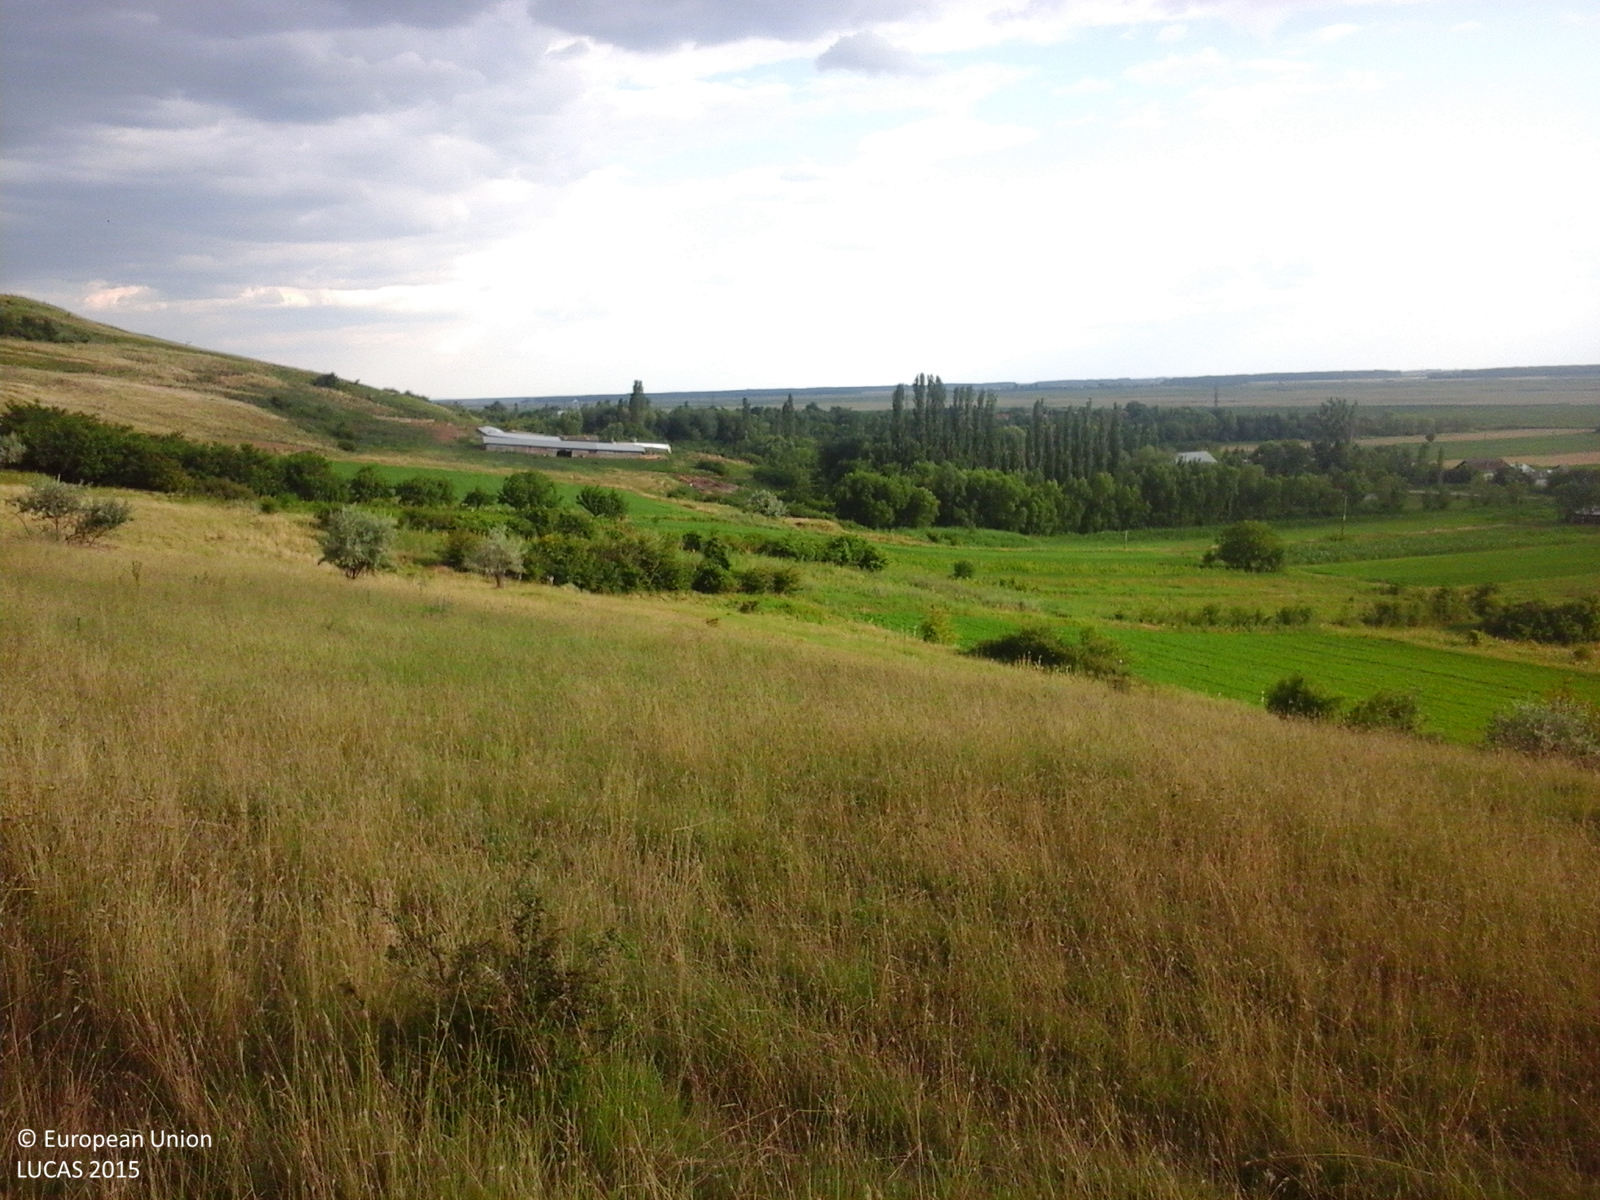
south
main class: Grassland
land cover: Grassland with sparse tree/shrub cover
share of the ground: > 75 %
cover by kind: herbaceous plants 85 %, shrubs 10 %, broadleaved forest trees 5 %
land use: Agriculture (excluding fallow land and kitchen gardens)
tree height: < 5 m
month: July
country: RO
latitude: 44.1166
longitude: 24.6016
